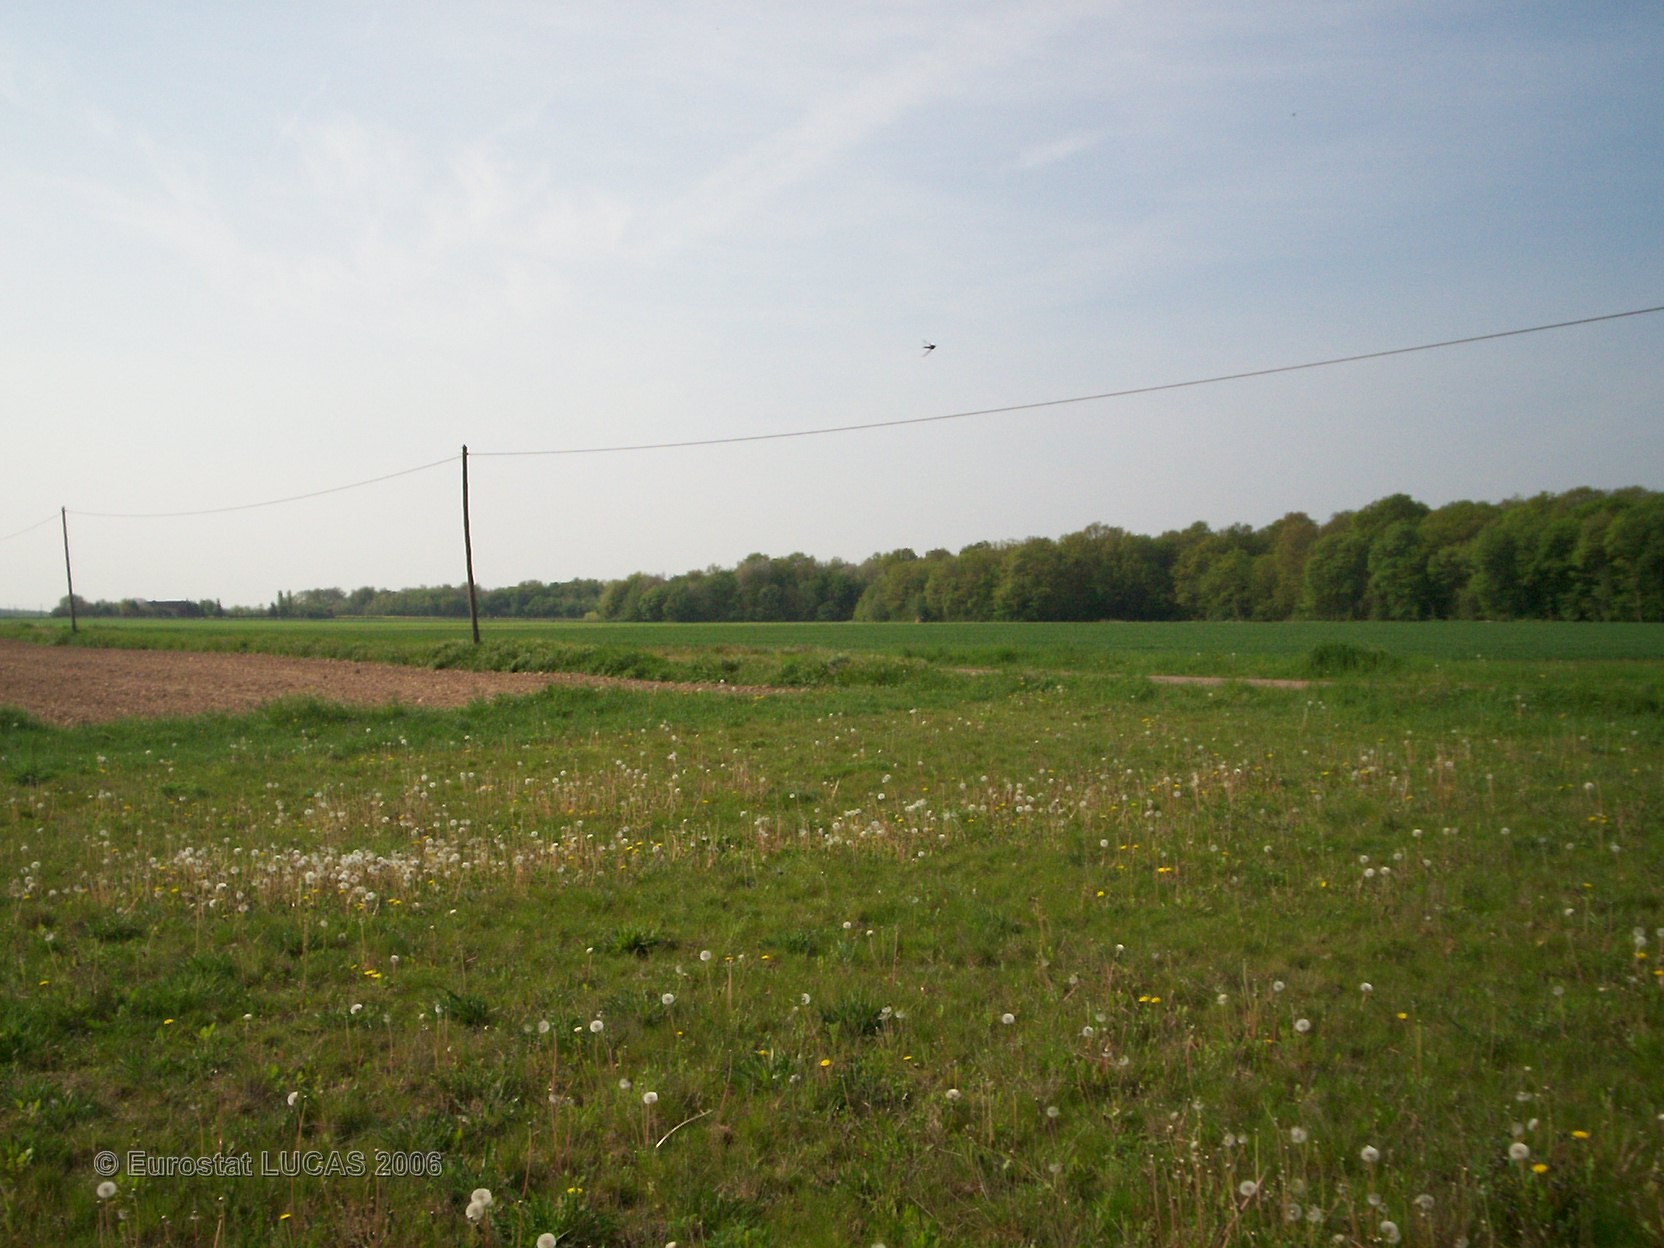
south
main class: Grassland
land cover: Grassland without tree/shrub cover
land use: Fallow land
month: May
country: FR
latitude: 48.0842
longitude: 2.8907
